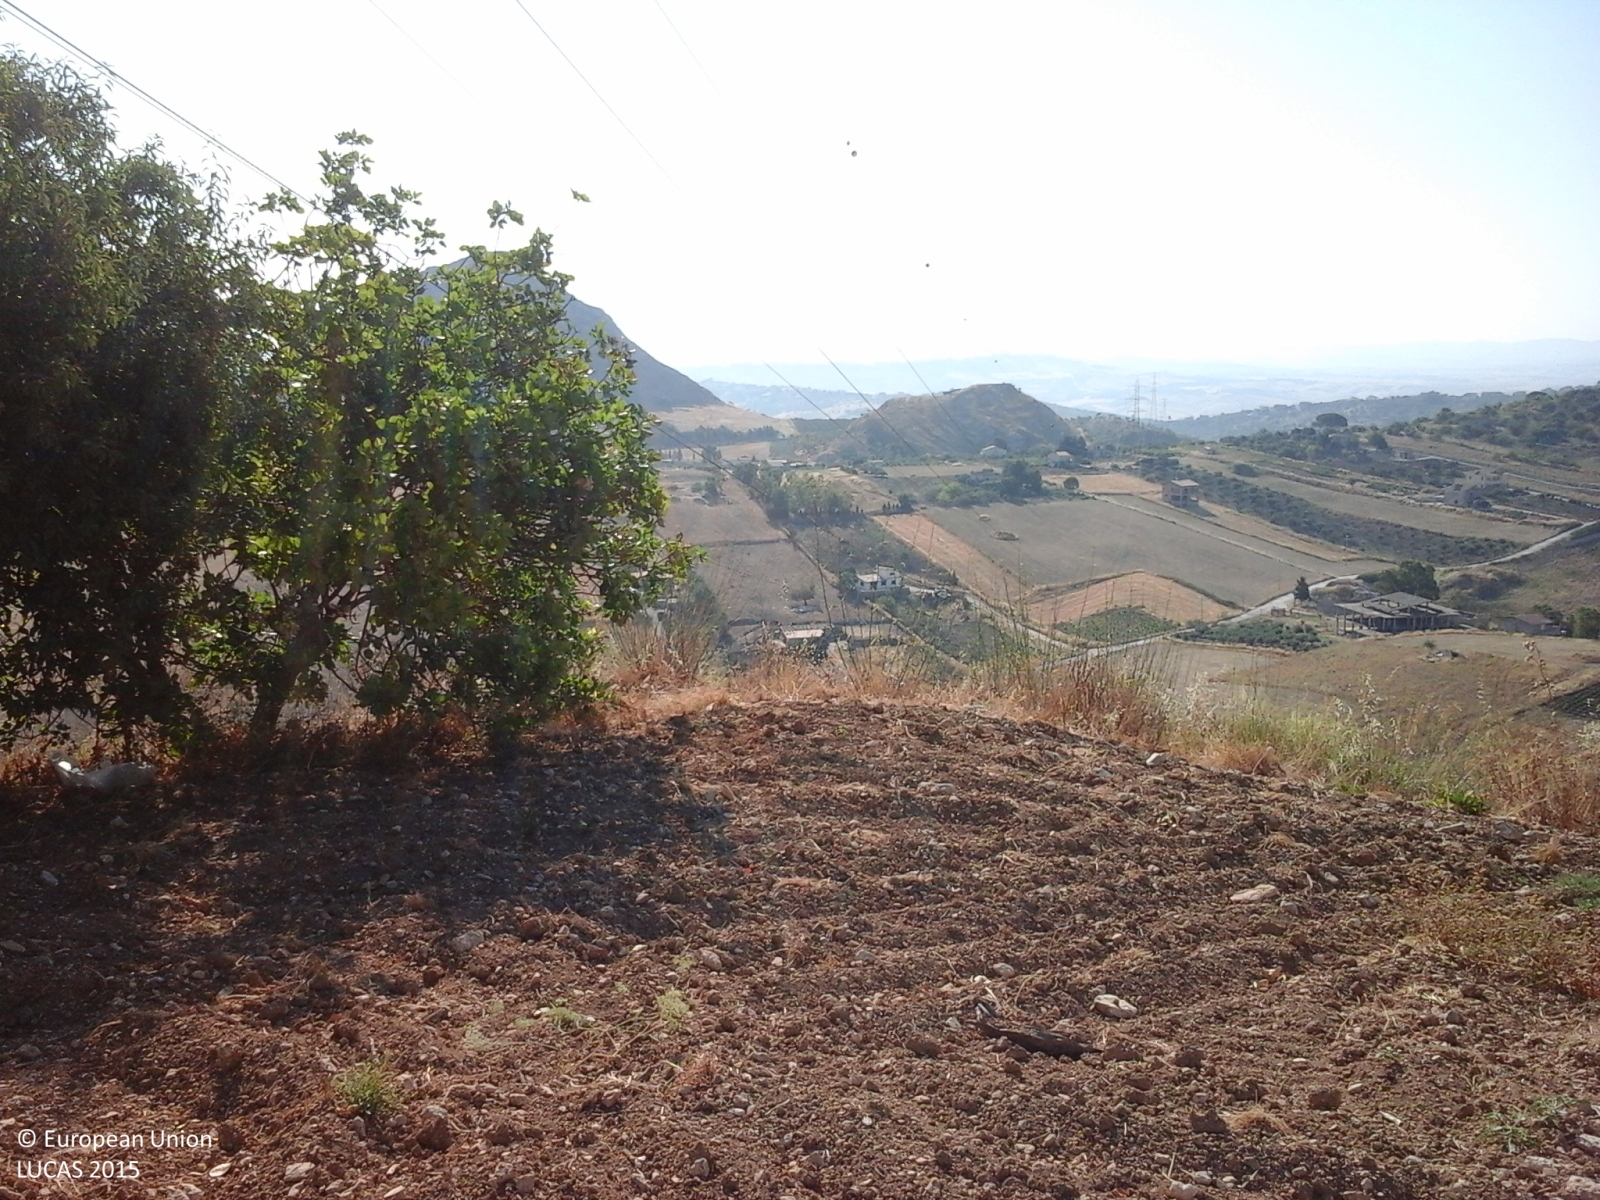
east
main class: Cropland
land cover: Nuts trees
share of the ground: 25 - 50 %
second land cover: Other bare soil
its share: > 75 %
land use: Agriculture (excluding fallow land and kitchen gardens)
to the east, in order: Nuts trees; Other bare soil; Electric lines; Shrubland without tree cover; Fences; Shrubland without tree cover; Broadleaved woodland; Olive groves
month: July
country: IT
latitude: 37.4284
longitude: 13.5101
